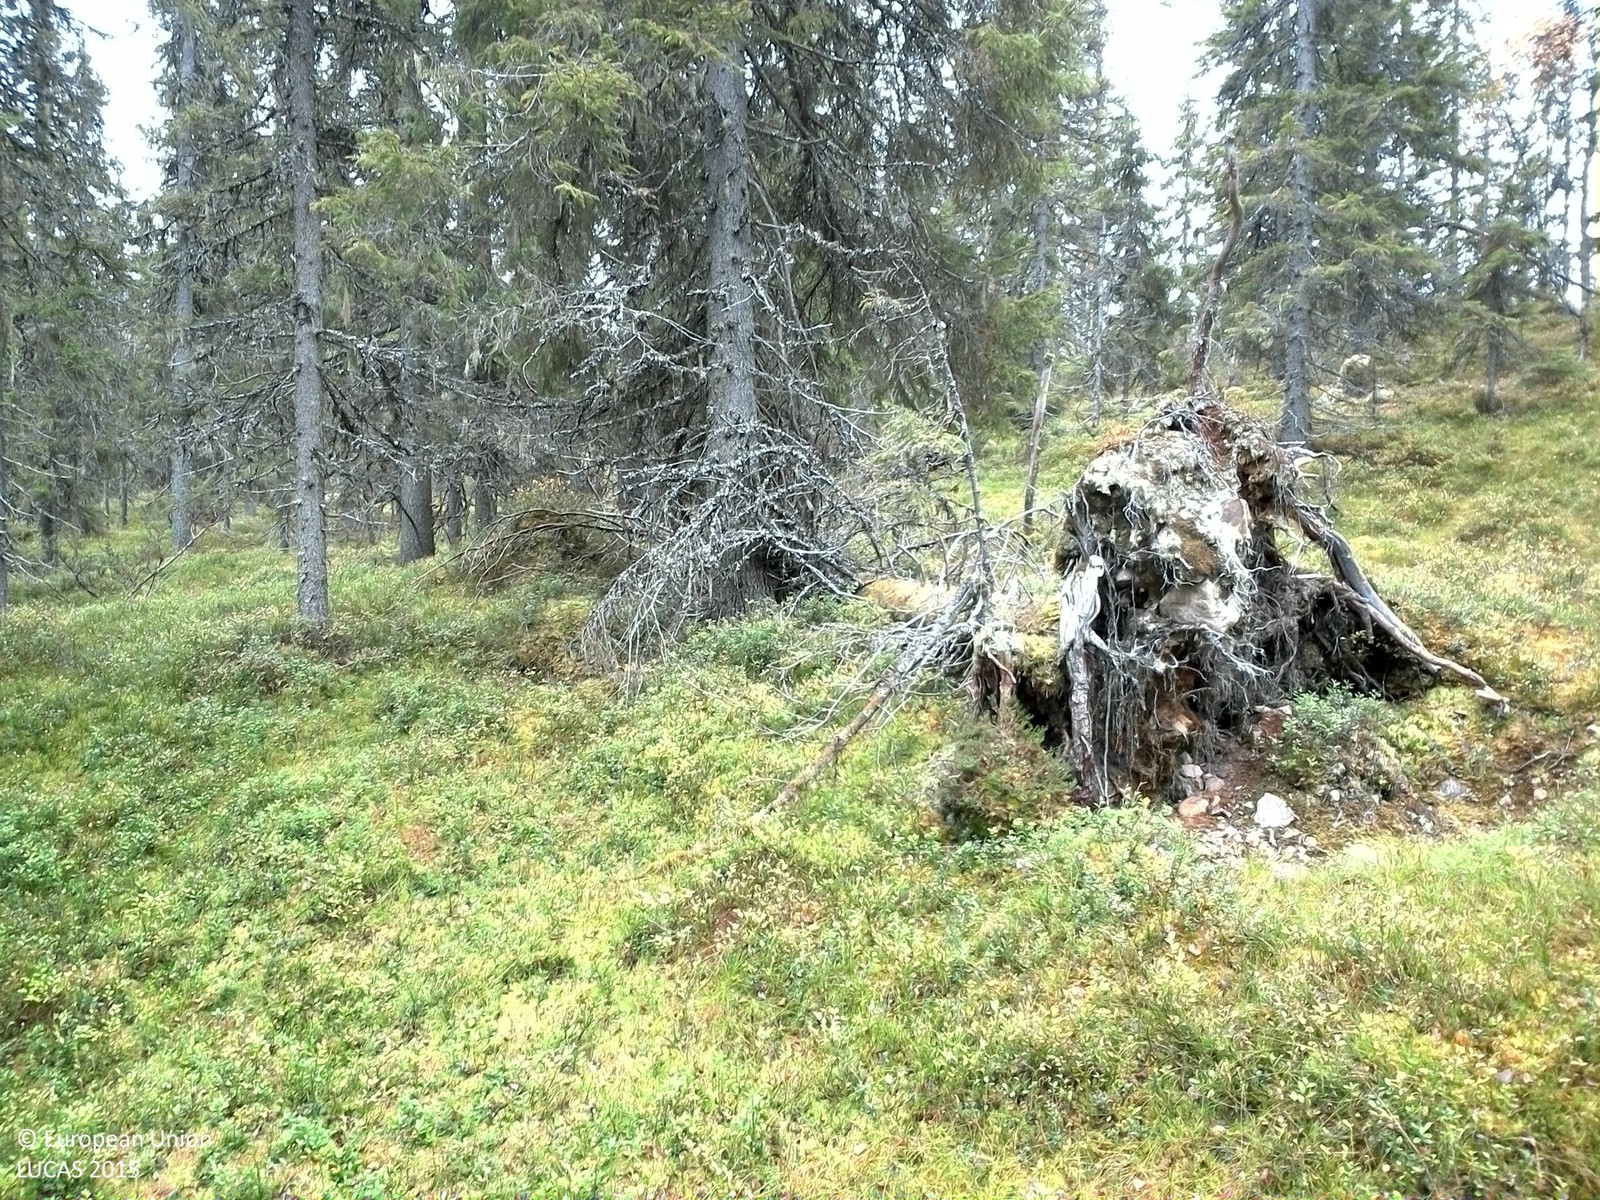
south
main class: Woodland
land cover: Spruce dominated coniferous woodland
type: boreal forest
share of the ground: 25 - 50 %
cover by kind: coniferous forest trees 45 %, shrubs 35 %, lichens and mosses 20 %
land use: Amenities, museums, leisure
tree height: > 5 m
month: October
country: SE
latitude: 61.3584
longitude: 14.3433
